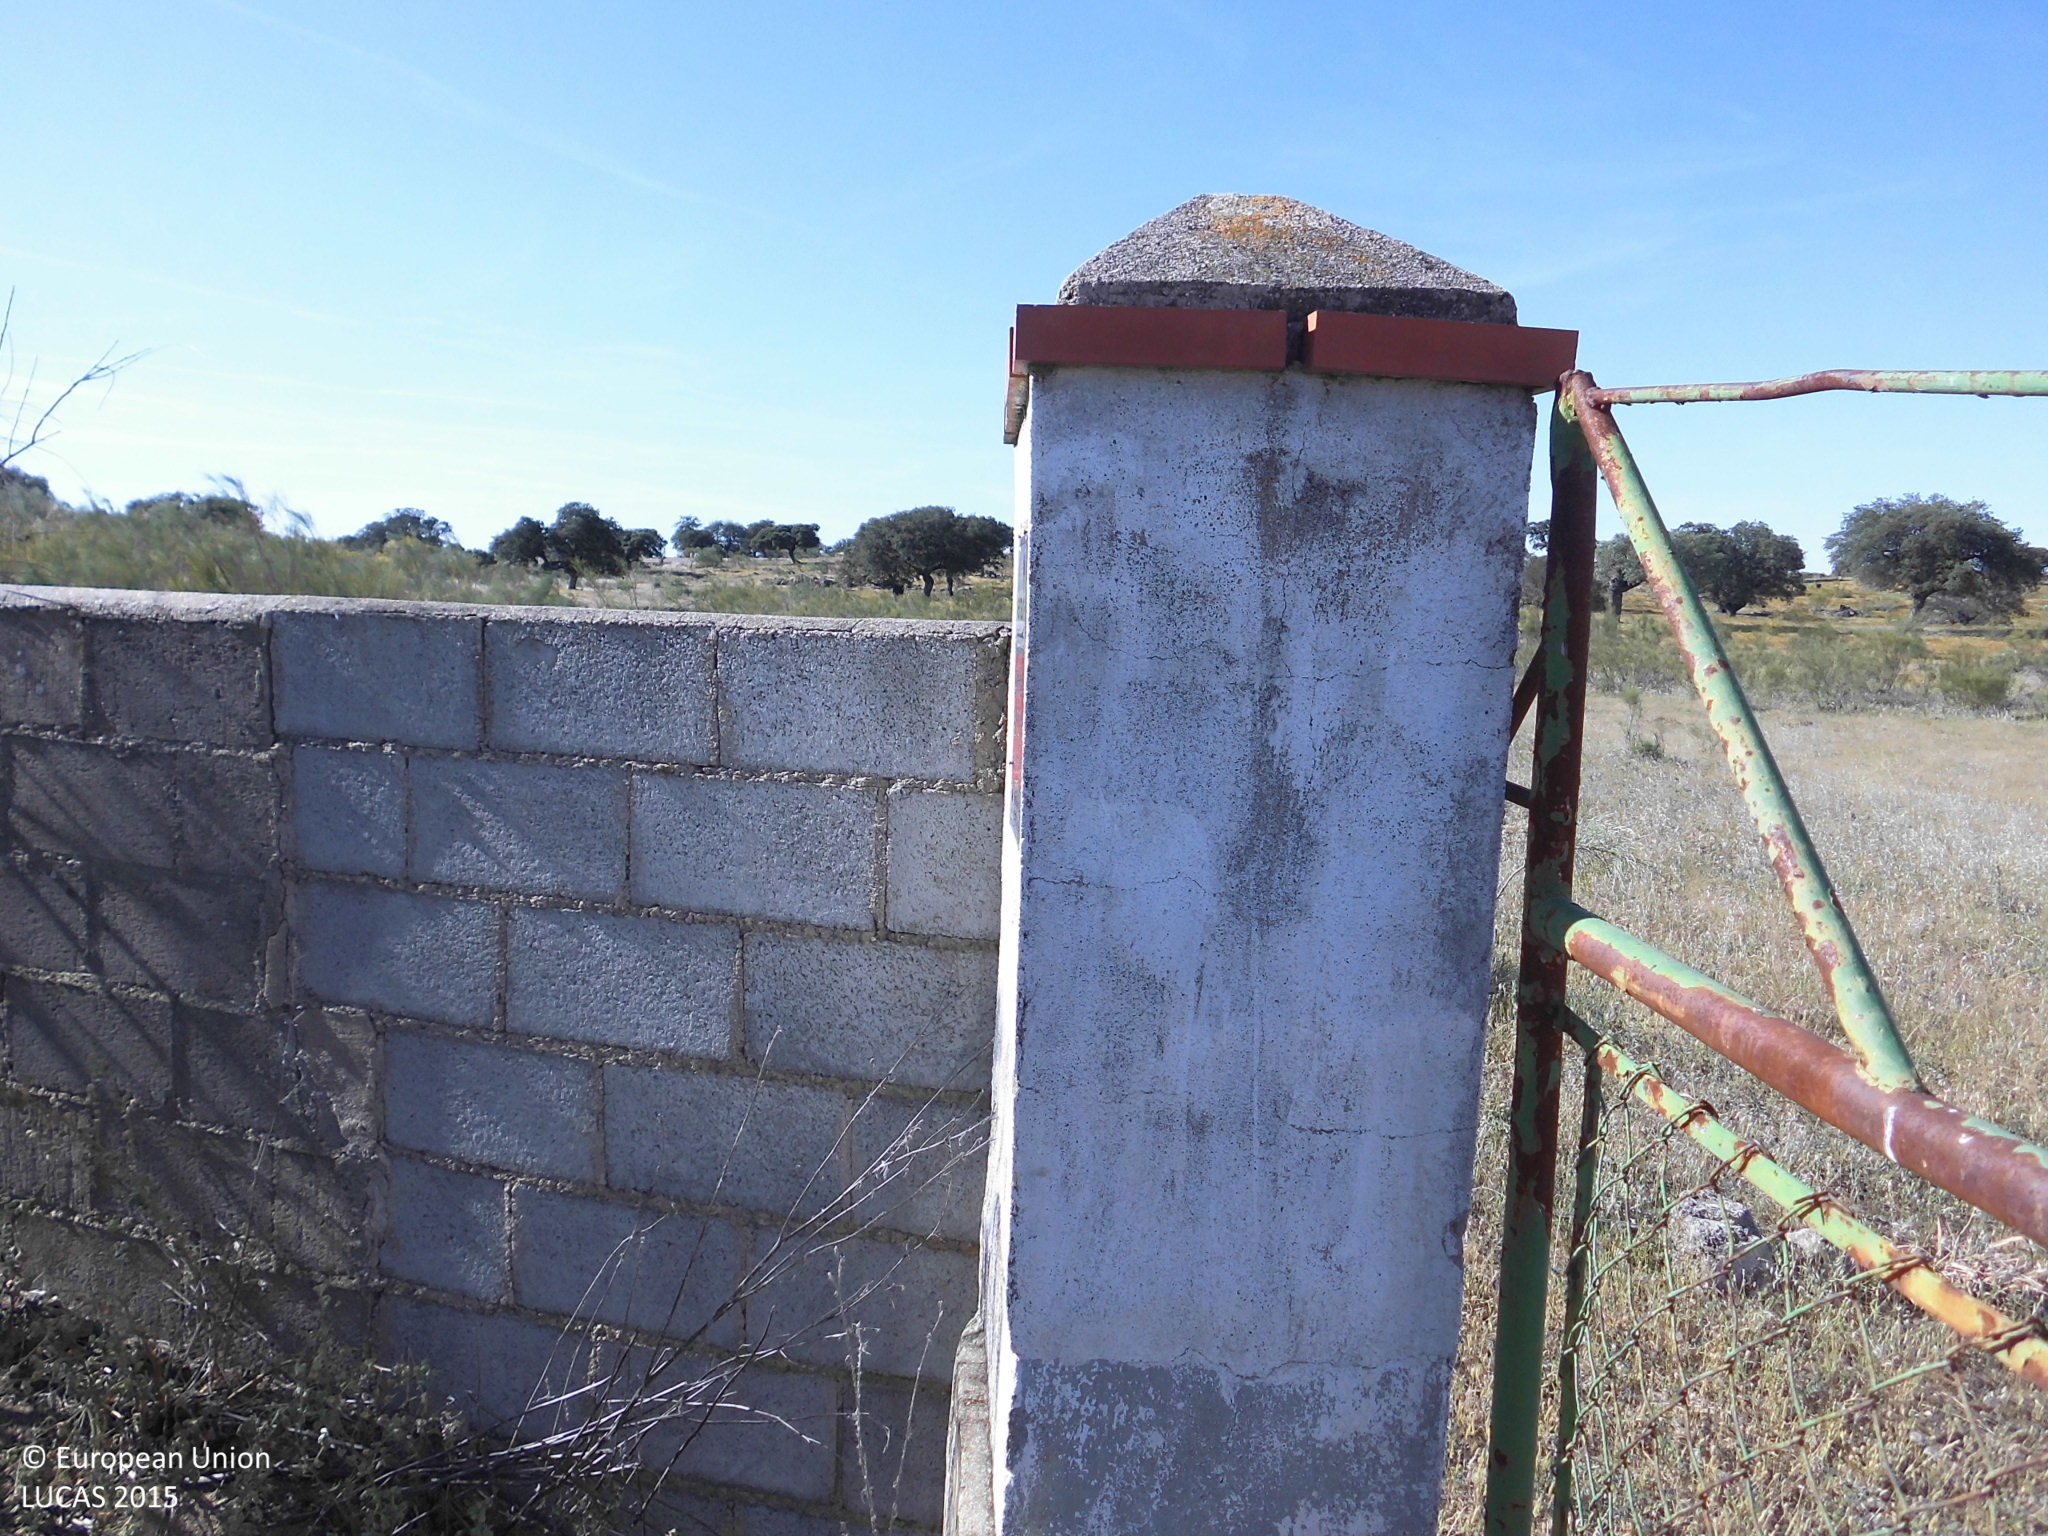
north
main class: Shrubland
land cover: Shrubland without tree cover
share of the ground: 10 - 25 %
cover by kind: herbaceous plants 80 %, shrubs 20 %
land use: Agriculture (excluding fallow land and kitchen gardens)
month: May
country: ES
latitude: 39.4796
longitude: -6.8538
